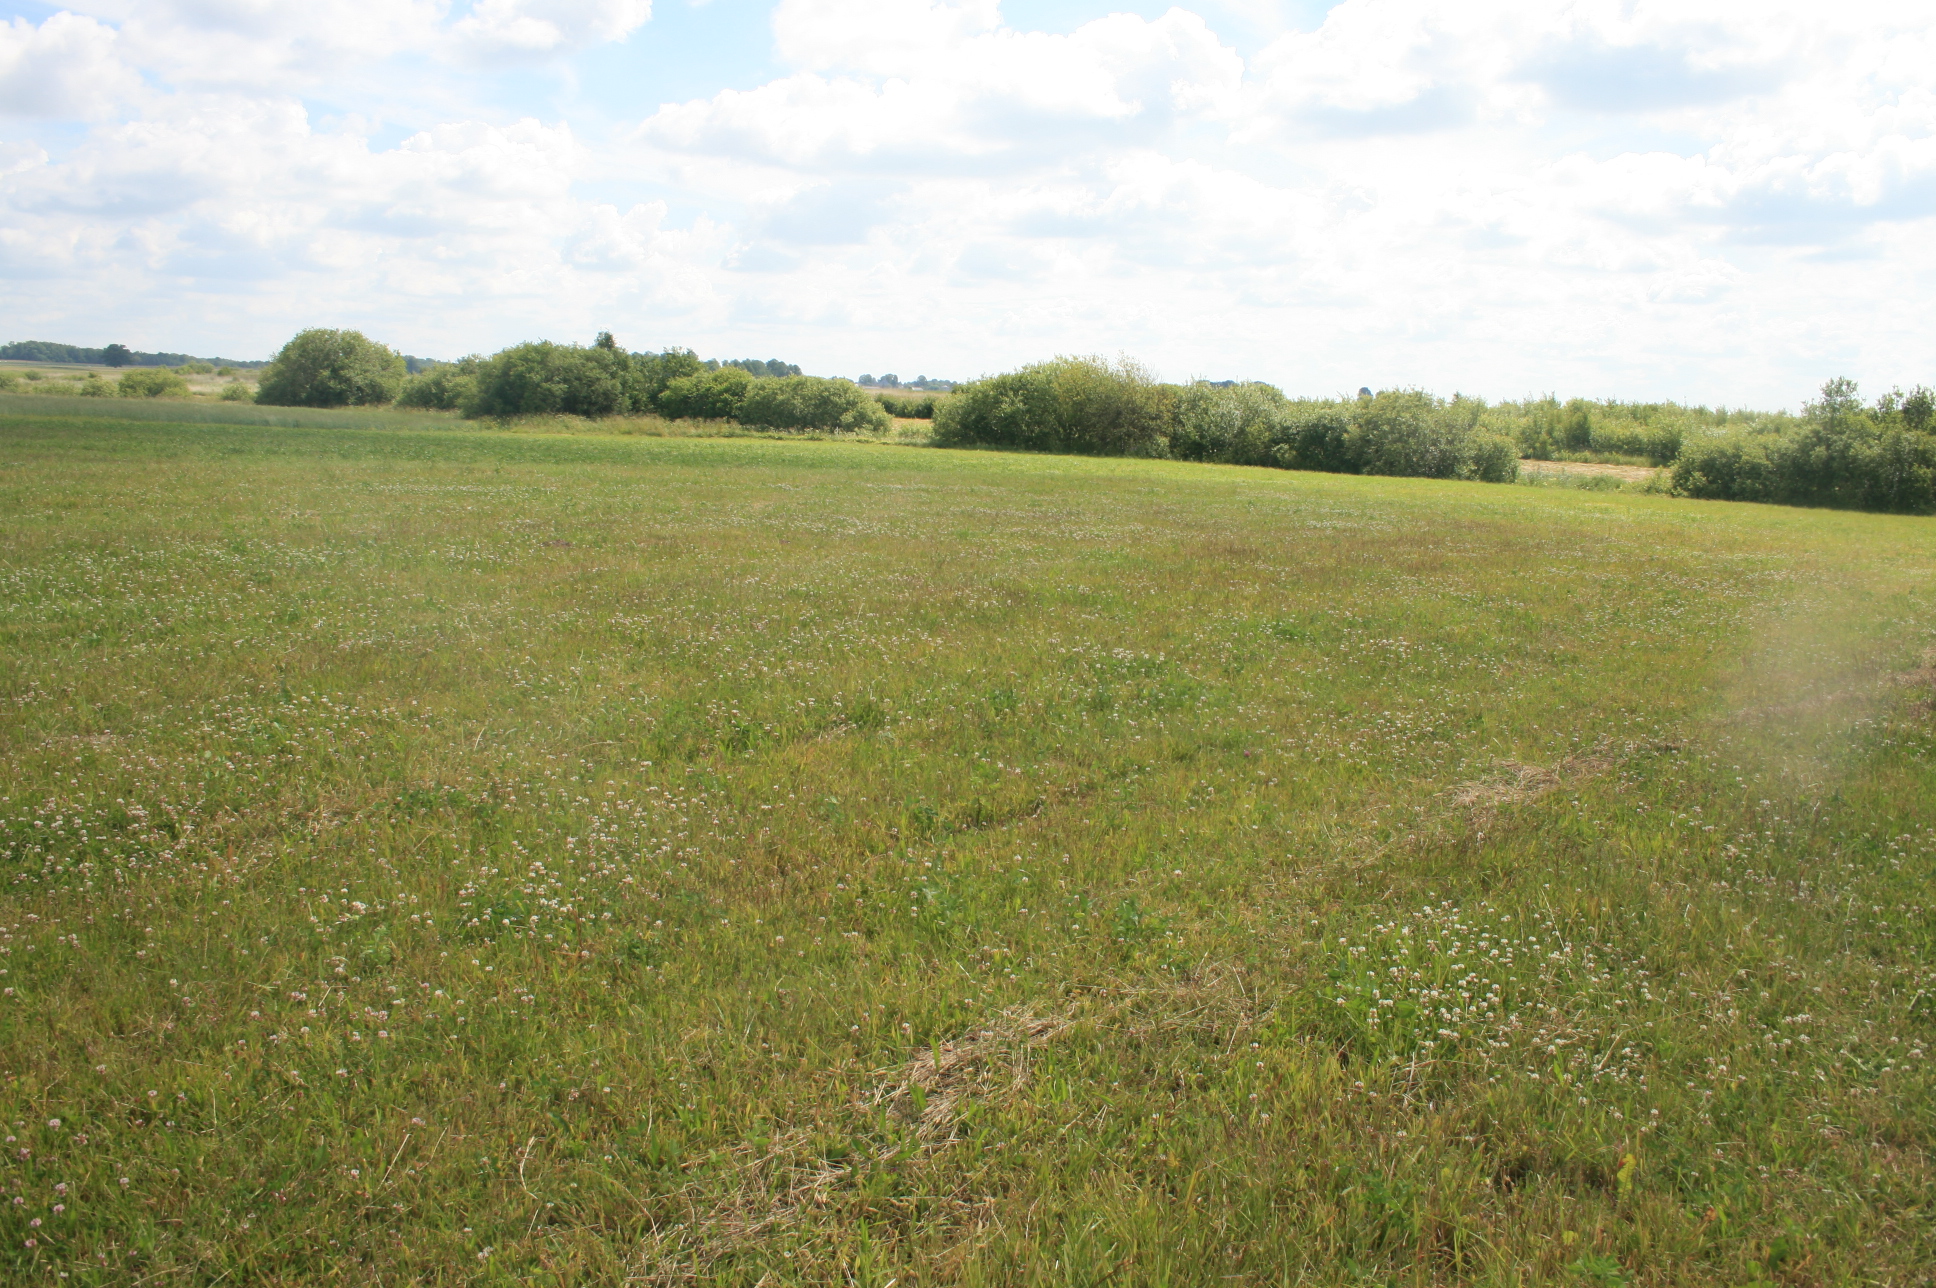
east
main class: Grassland
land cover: Grassland without tree/shrub cover
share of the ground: > 75 %
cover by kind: herbaceous plants 100 %
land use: Agriculture (excluding fallow land and kitchen gardens)
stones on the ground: < 10 %
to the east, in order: Grassland without tree/shrub cover; Shruby margins; Abandoned hedges; Ditches and canals; Abandoned hedges; Shruby margins; Grassland without tree/shrub cover; Abandoned hedges; Grassland without tree/shrub cover; Single bushes/trees; Grassland without tree/shrub cover; Common wheat
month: June
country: LT
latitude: 55.3205
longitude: 21.7270
